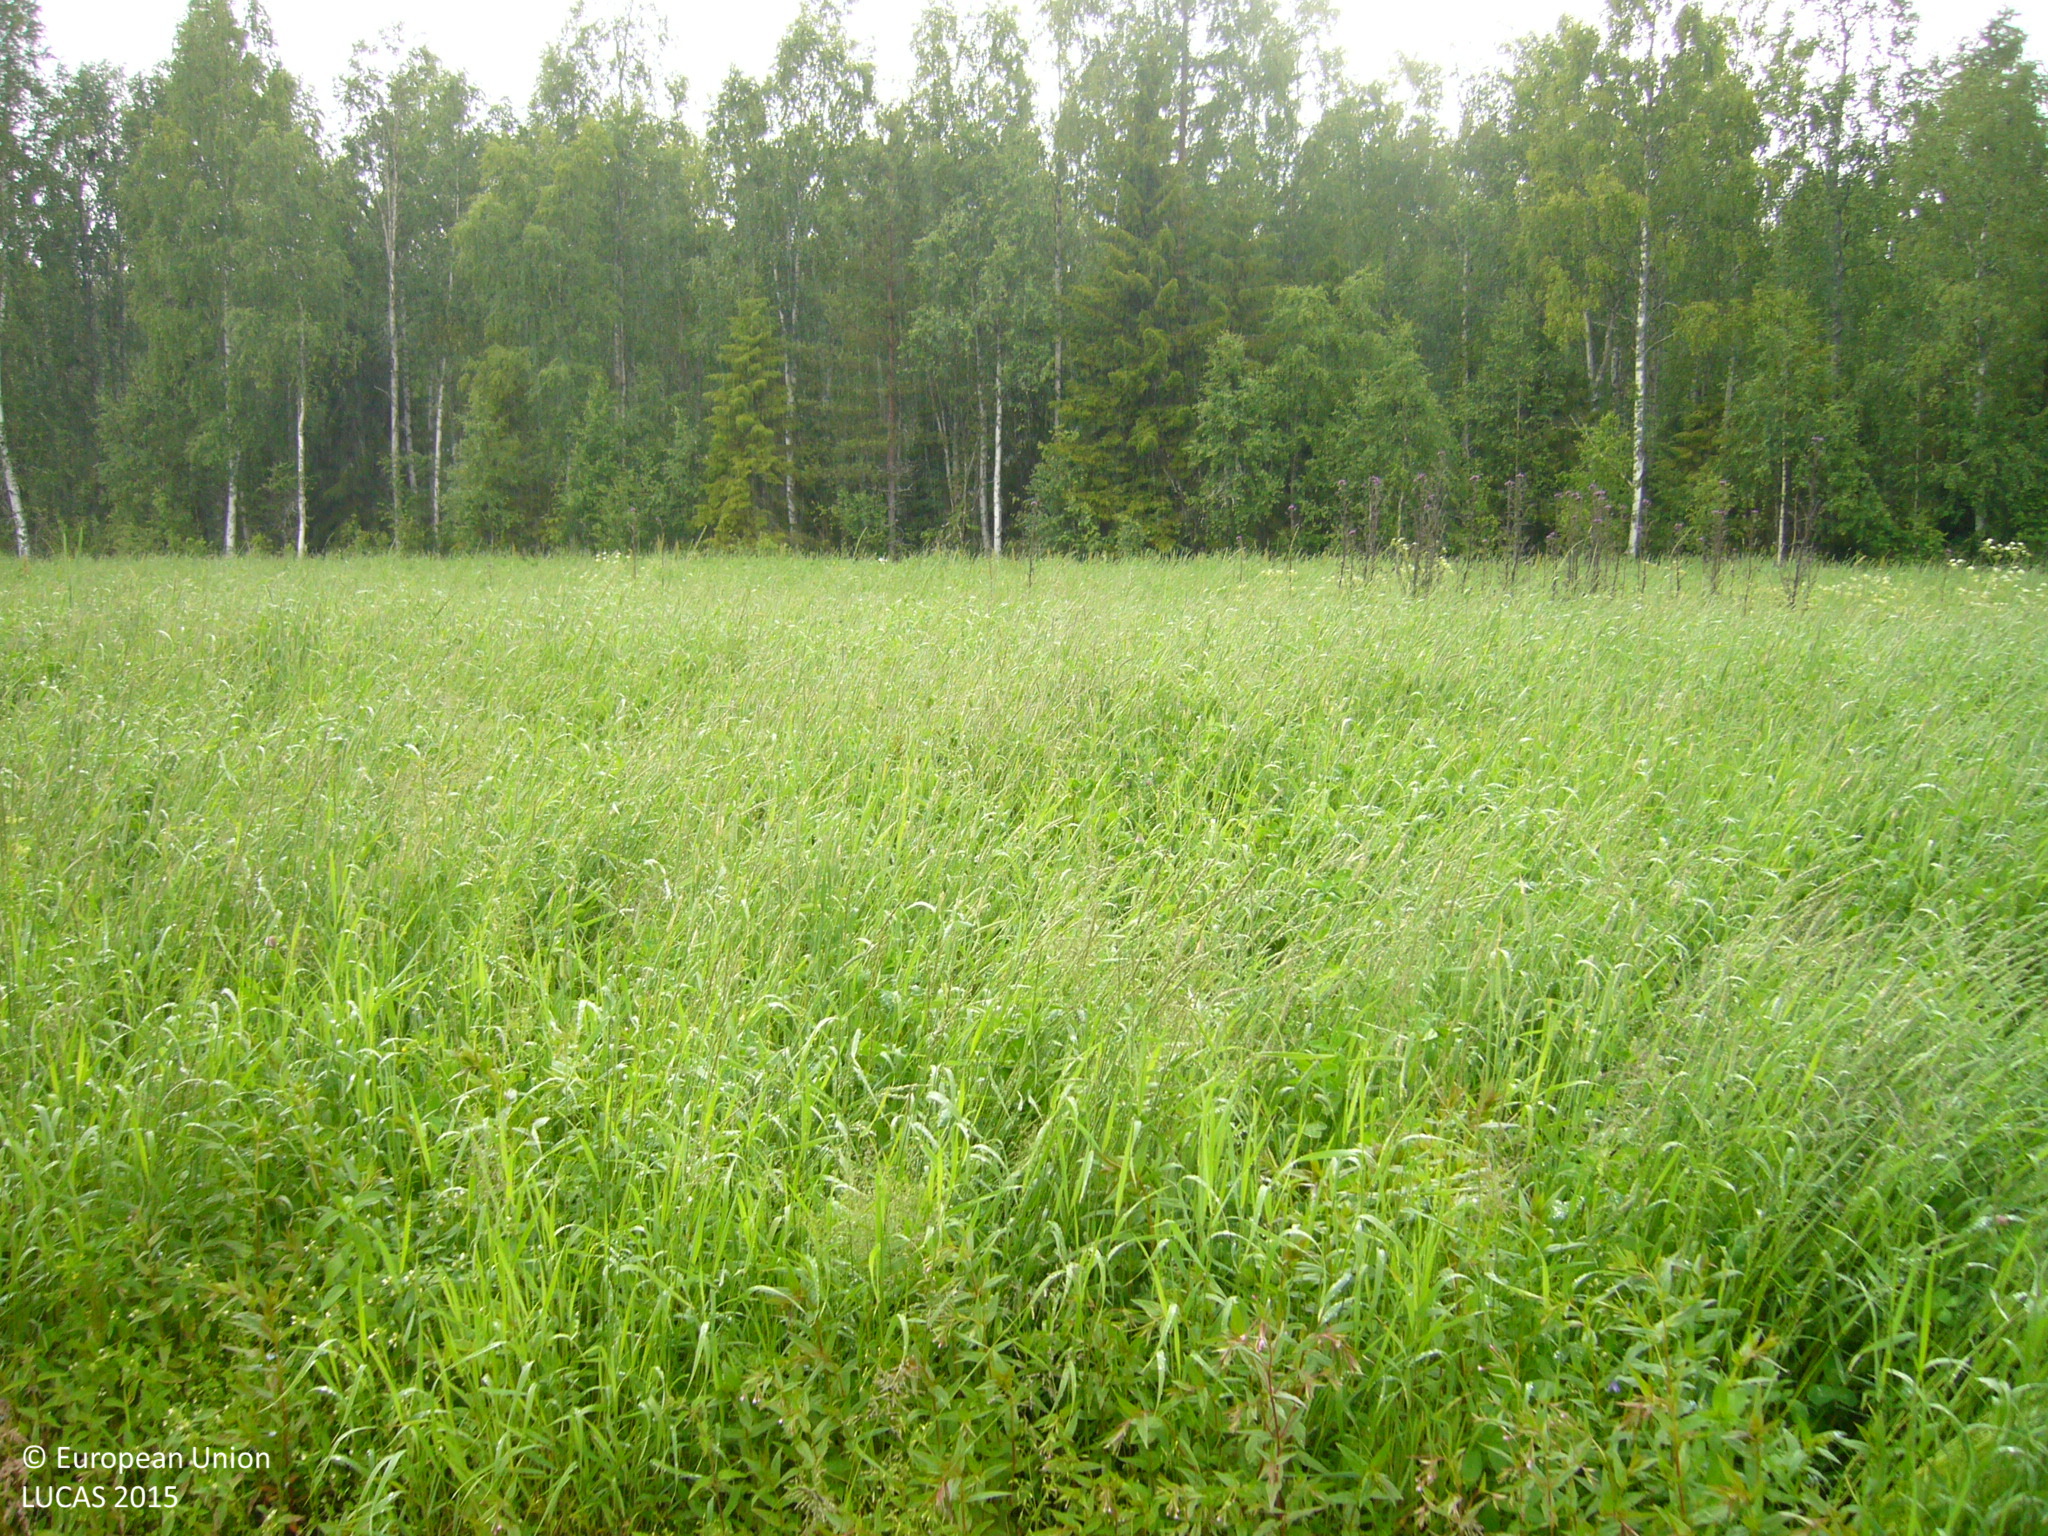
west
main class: Cropland
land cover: Temporary grasslands
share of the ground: > 75 %
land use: Agriculture (excluding fallow land and kitchen gardens)
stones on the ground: < 10 %
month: July
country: FI
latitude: 63.4255
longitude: 25.5099
